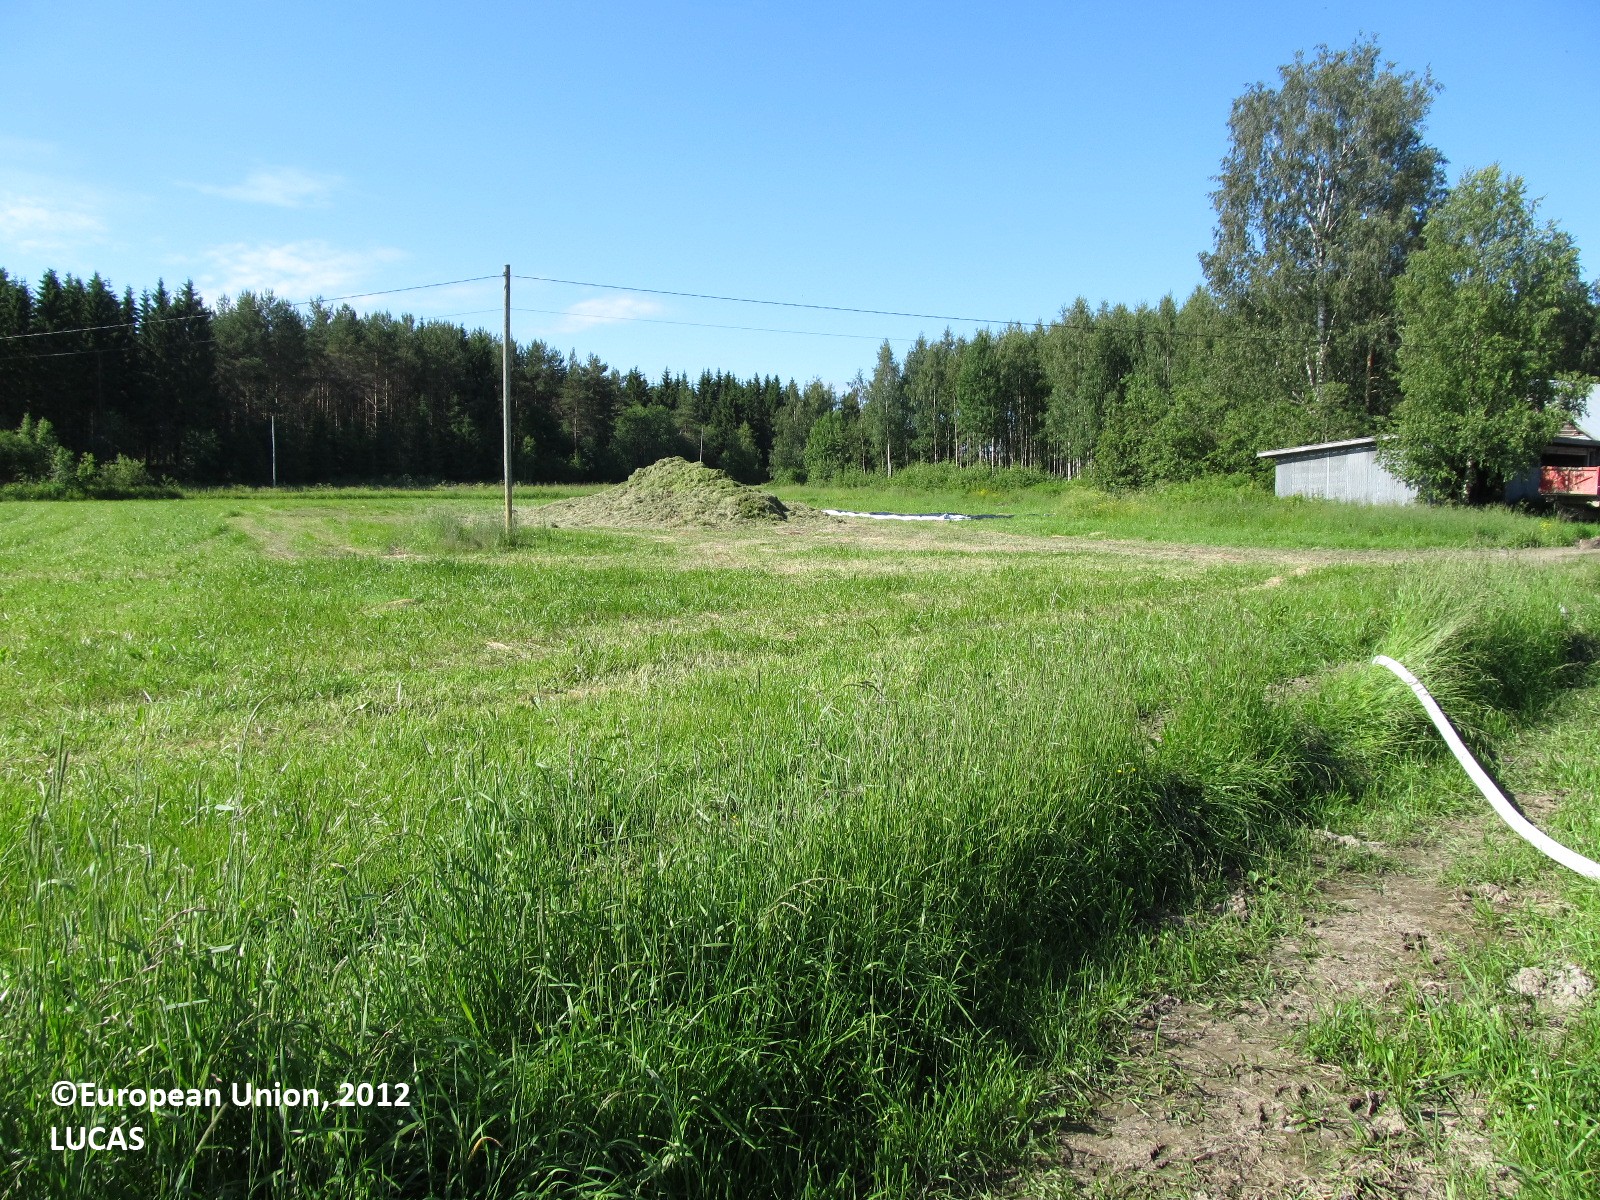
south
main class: Grassland
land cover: Grassland without tree/shrub cover
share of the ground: > 75 %
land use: Agriculture (excluding fallow land and kitchen gardens)
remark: Harvested field
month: July
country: FI
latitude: 62.6320
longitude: 29.1576
